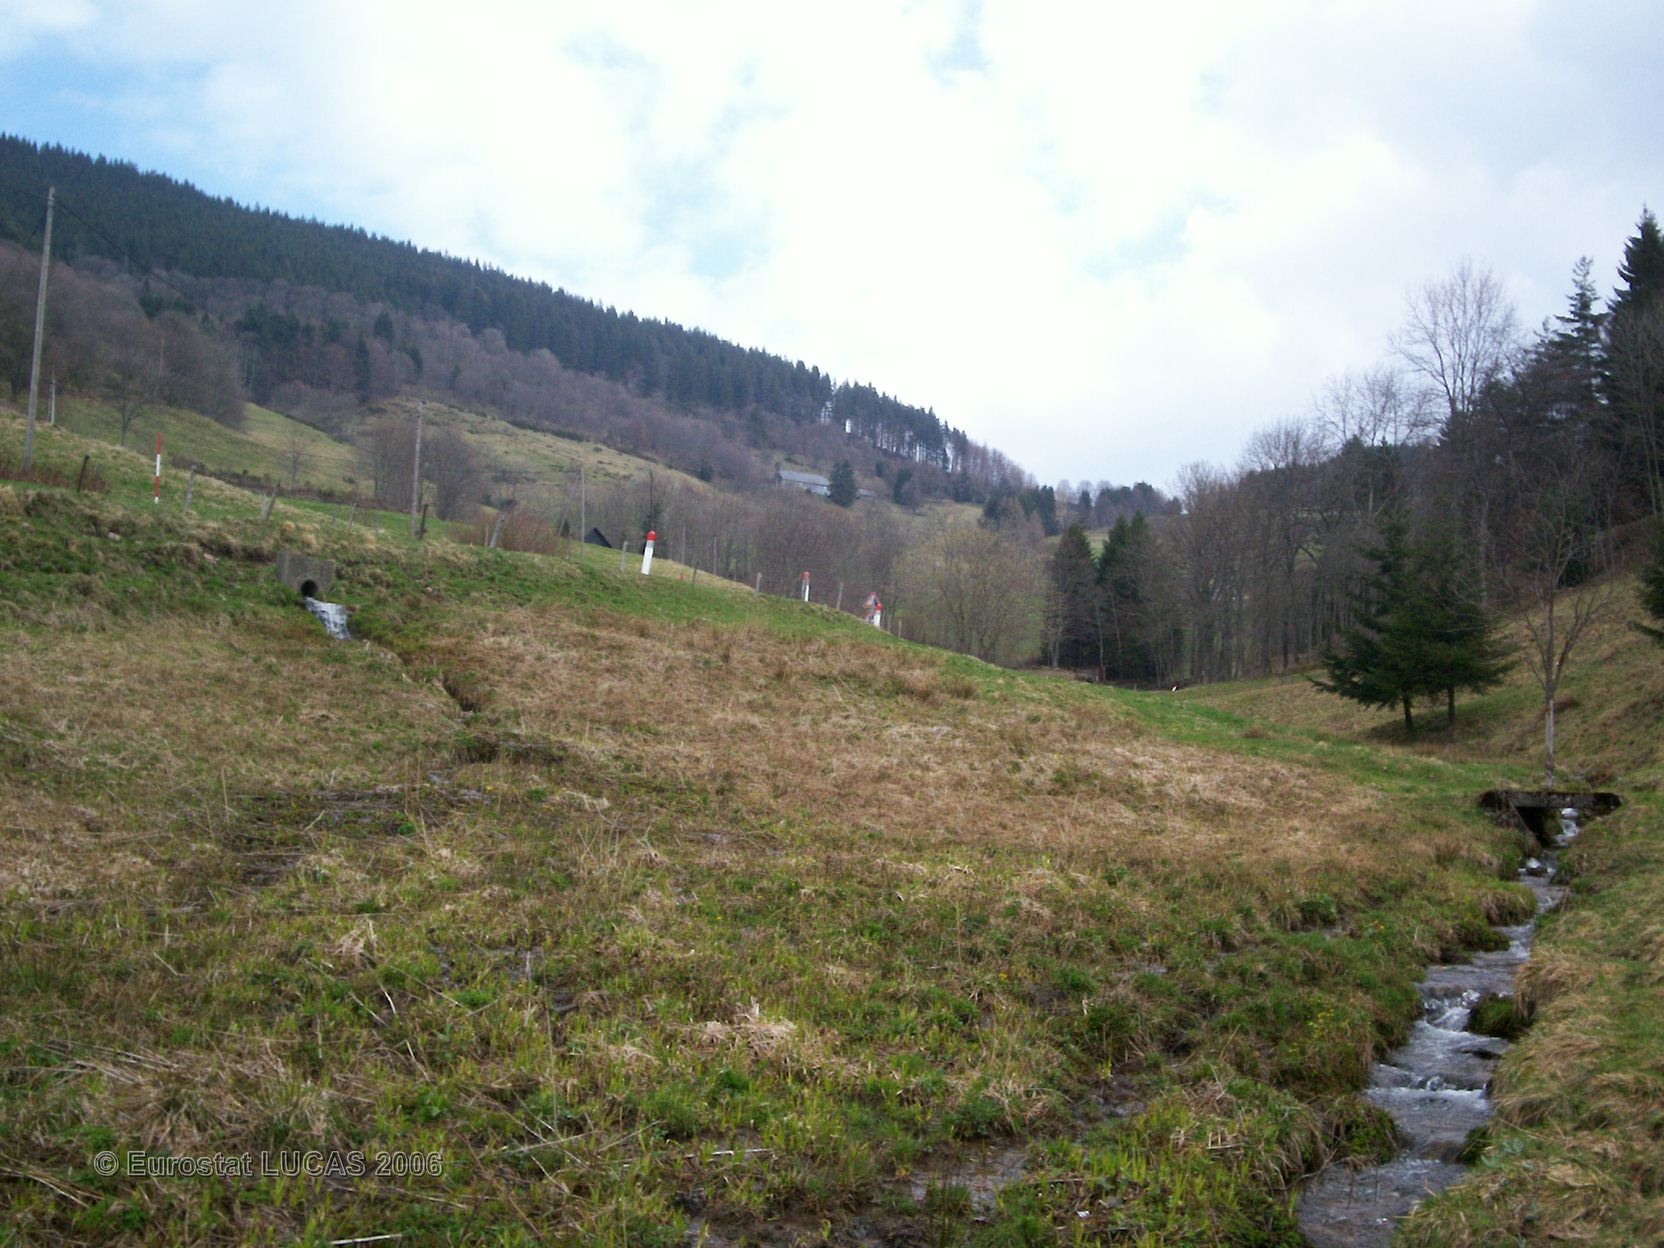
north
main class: Grassland
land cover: Grassland without tree/shrub cover
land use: Agriculture (excluding fallow land and kitchen gardens)
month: April
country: FR
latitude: 48.1857
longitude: 7.1091
